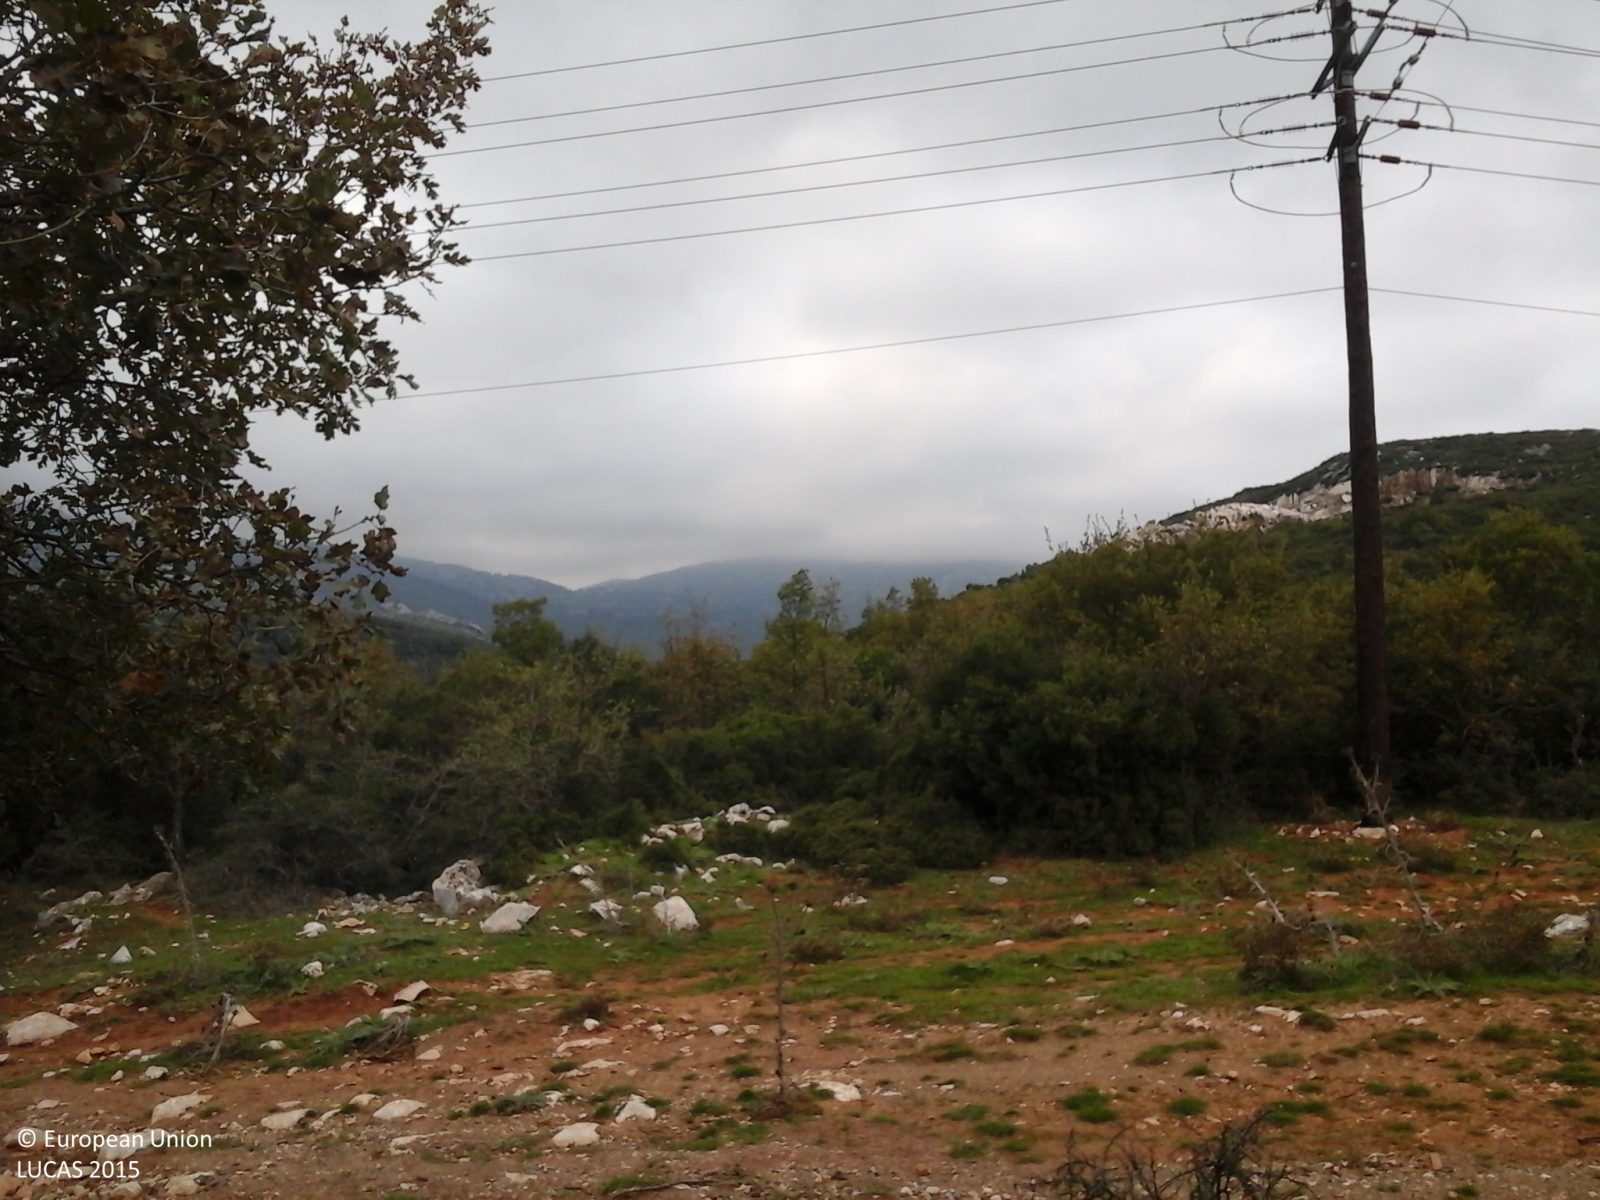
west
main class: Woodland
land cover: Broadleaved woodland
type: thermophilous deciduous forest
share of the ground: 25 - 50 %
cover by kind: broadleaved forest trees 50 %, shrubs 45 %, unconsolidated bare surface 5 %
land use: Semi-natural and natural areas not in use
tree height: > 5 m
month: October
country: GR
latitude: 38.3294
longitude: 22.9154
